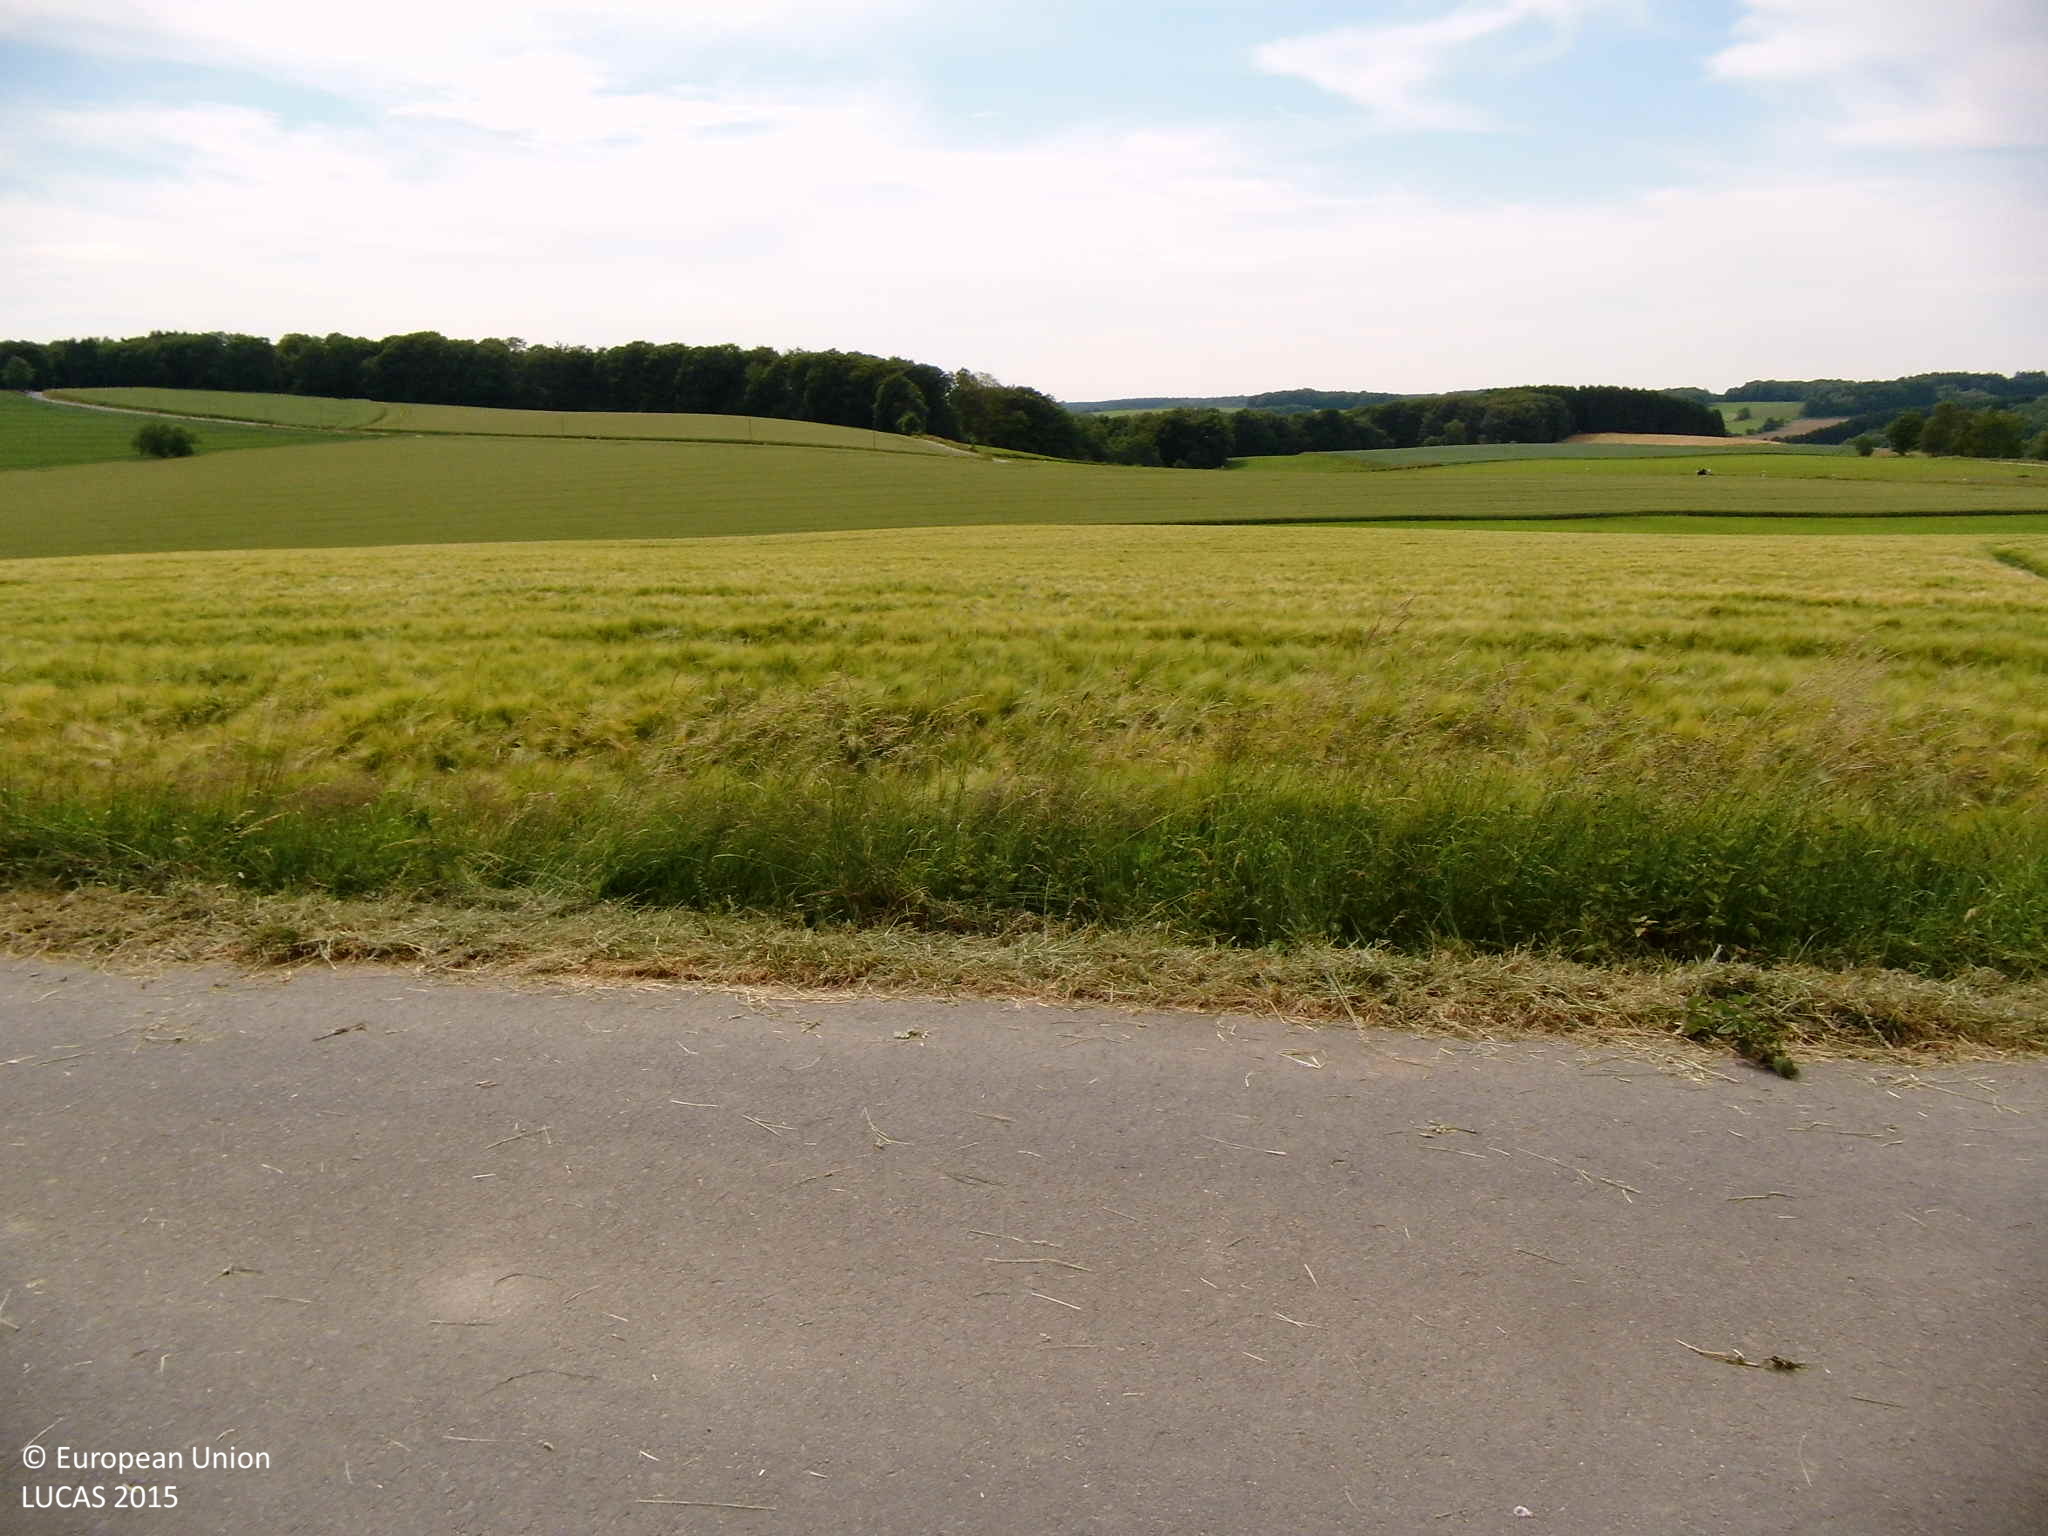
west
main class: Grassland
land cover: Grassland without tree/shrub cover
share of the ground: > 75 %
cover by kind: herbaceous plants 100 %
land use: Agriculture (excluding fallow land and kitchen gardens)
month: June
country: DE
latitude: 51.1809
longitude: 7.4395
